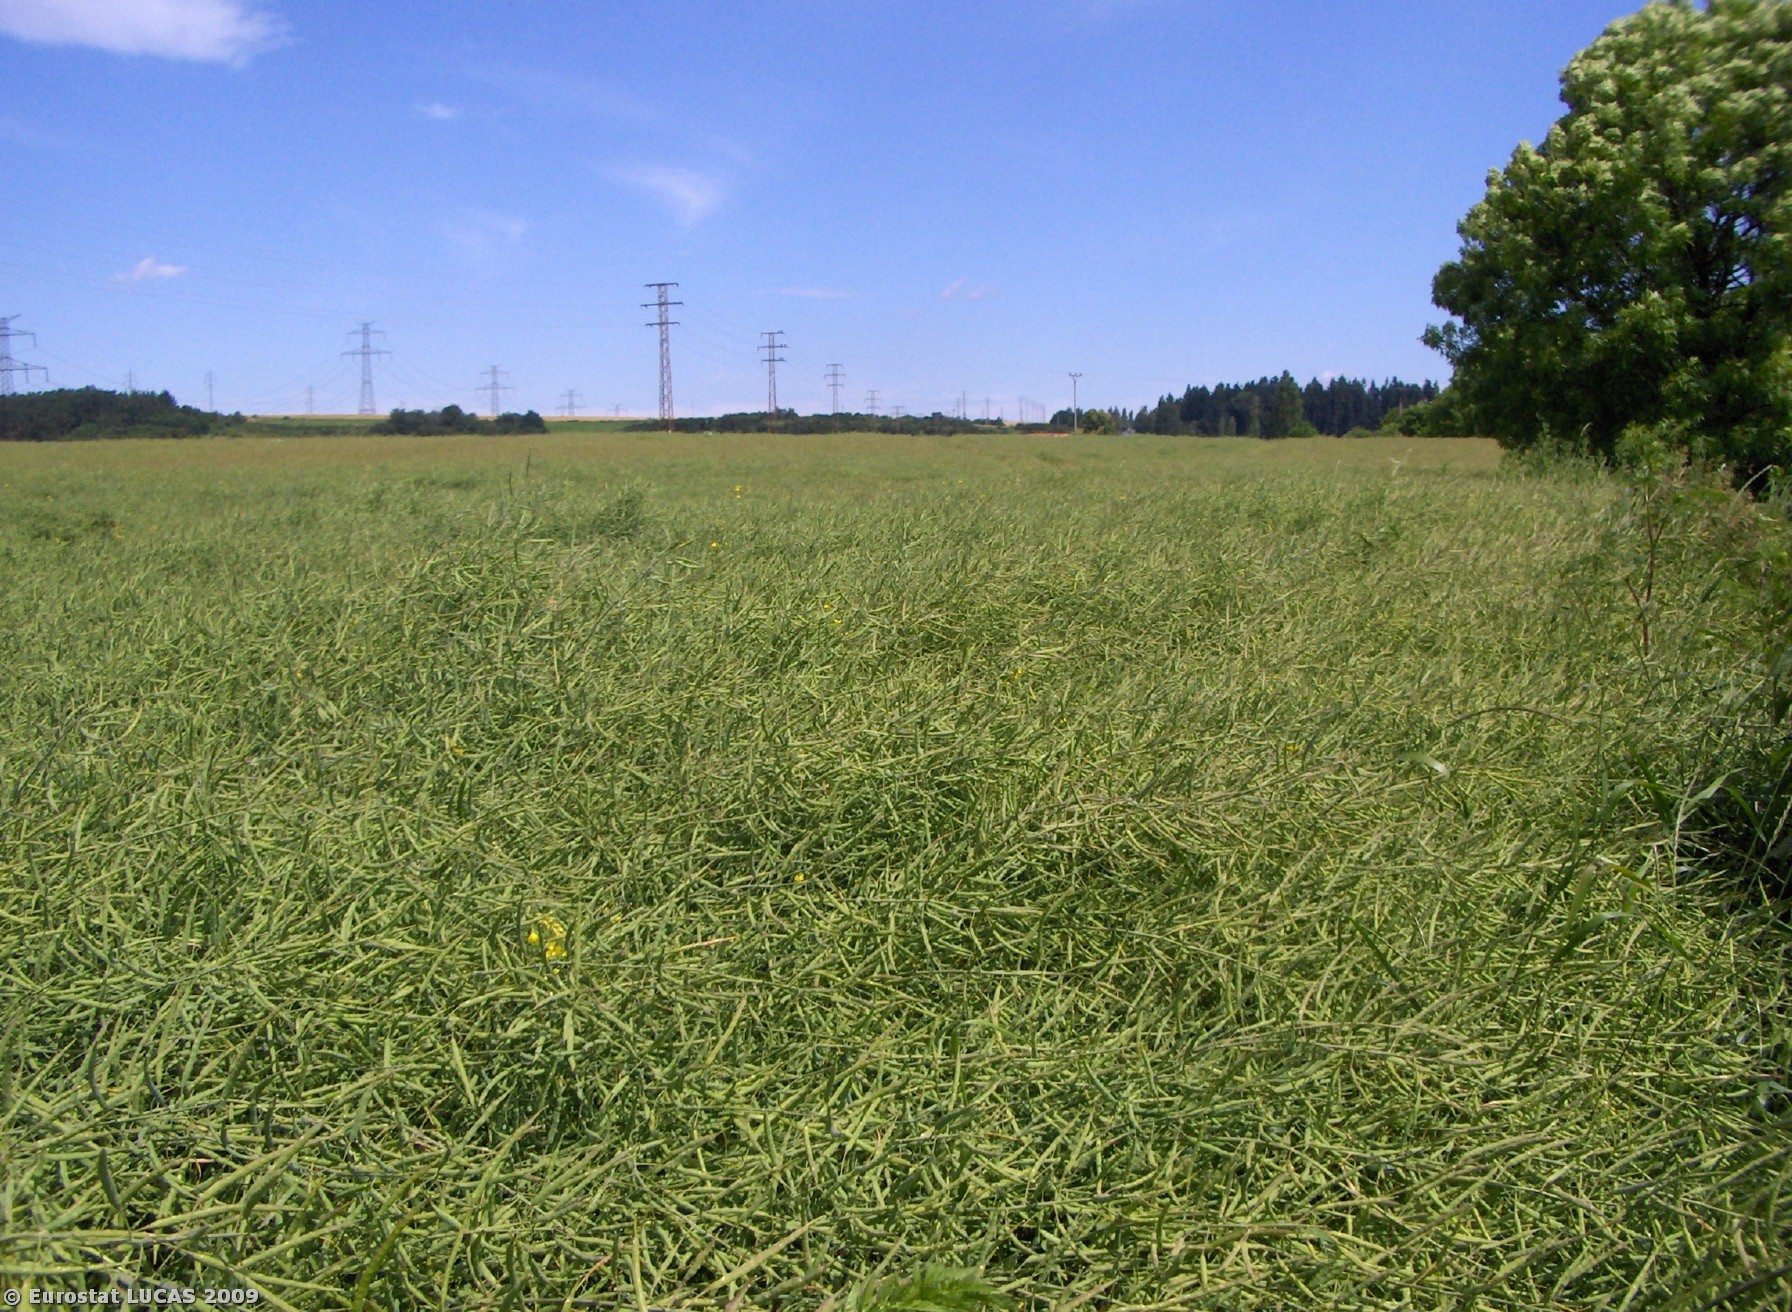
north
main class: Cropland
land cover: Rape and turnip rape
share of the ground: > 75 %
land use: Agriculture (excluding fallow land and kitchen gardens)
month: June
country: CZ
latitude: 49.5352
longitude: 14.0771
